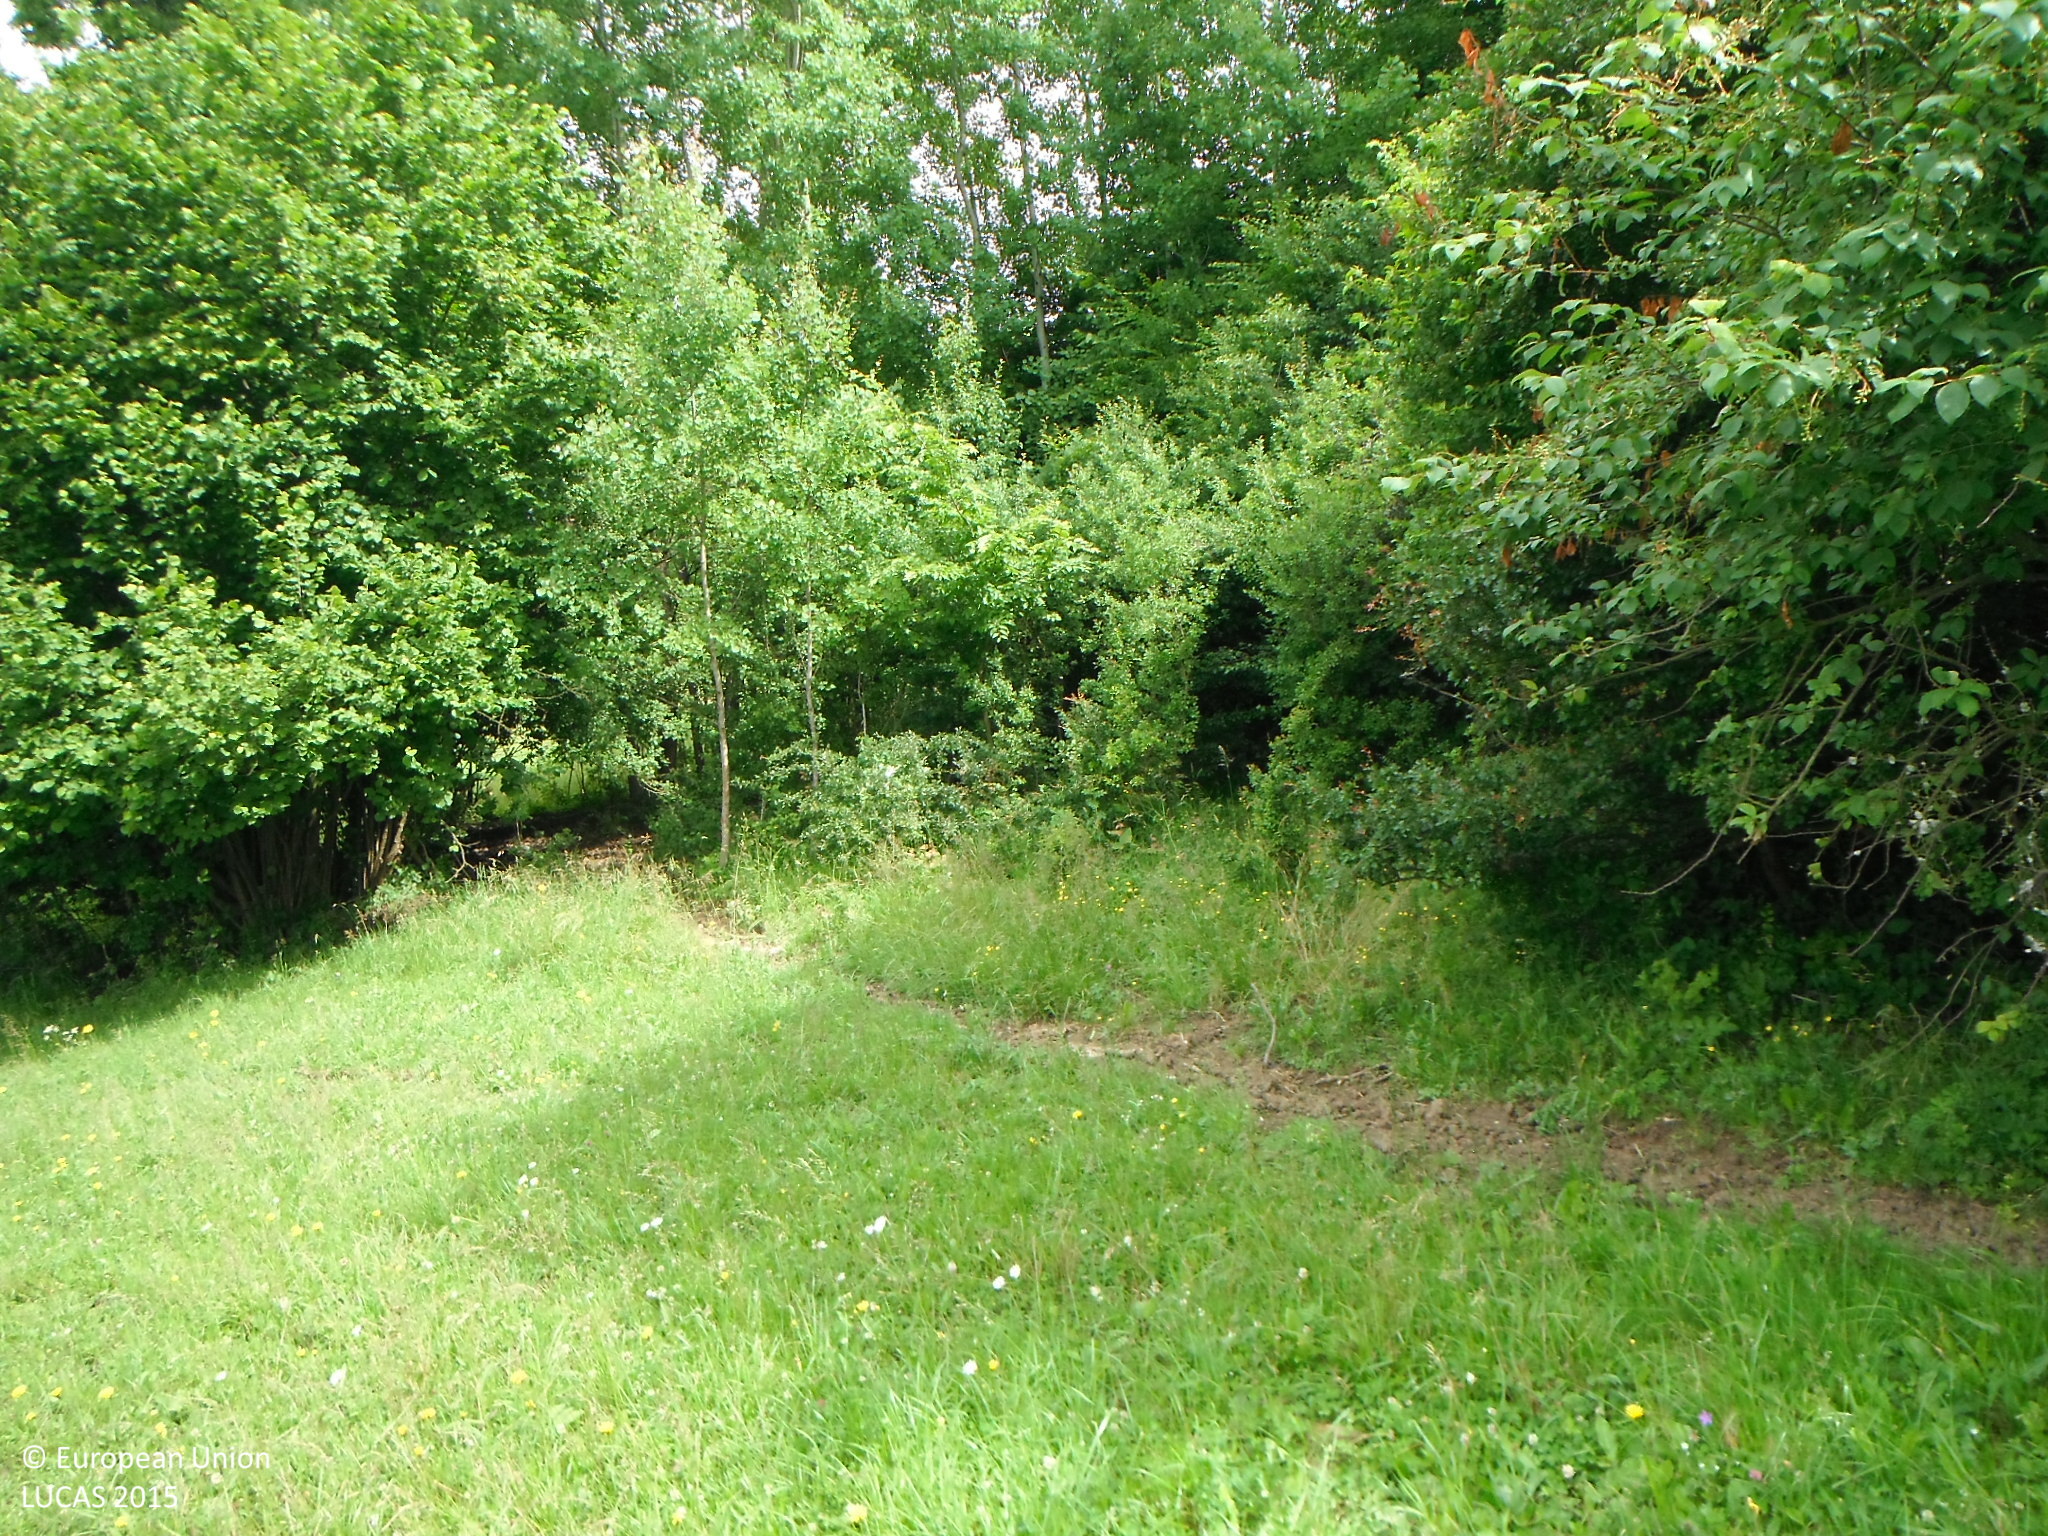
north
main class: Grassland
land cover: Grassland without tree/shrub cover
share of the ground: > 75 %
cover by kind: herbaceous plants 100 %
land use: Agriculture (excluding fallow land and kitchen gardens)
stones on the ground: < 10 %
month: June
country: SK
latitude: 49.2269
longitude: 19.2655
